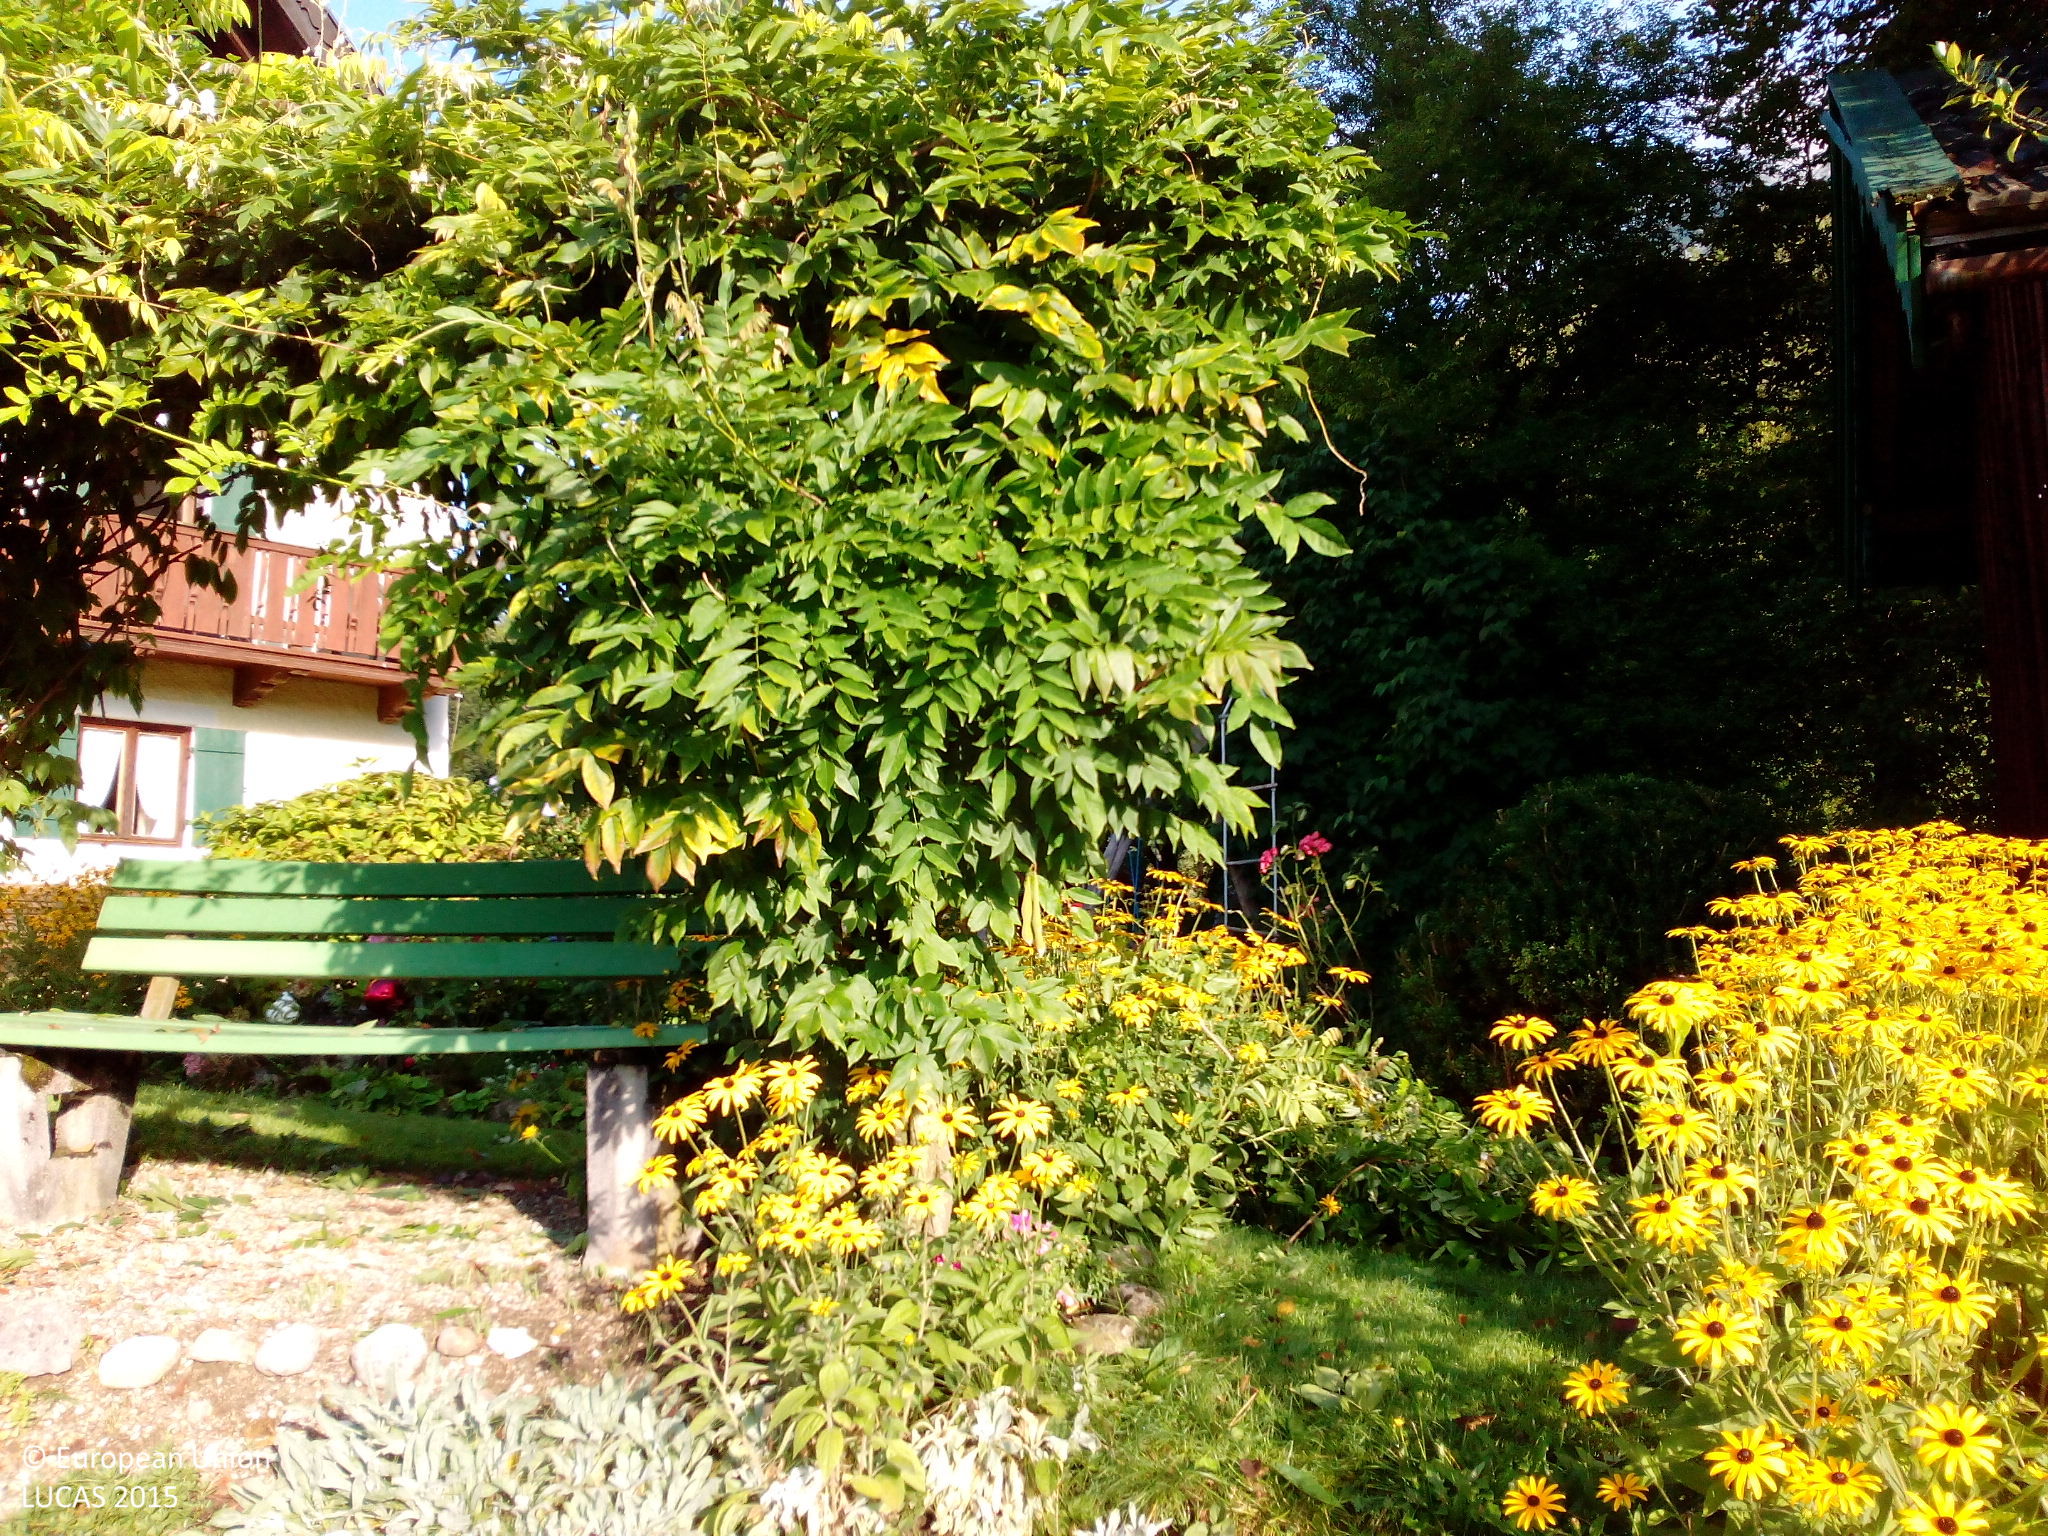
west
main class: Woodland
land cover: Broadleaved woodland
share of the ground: > 75 %
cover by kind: broadleaved forest trees 75 %, herbaceous plants 25 %
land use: Residential
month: August
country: DE
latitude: 47.7361
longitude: 12.8655
